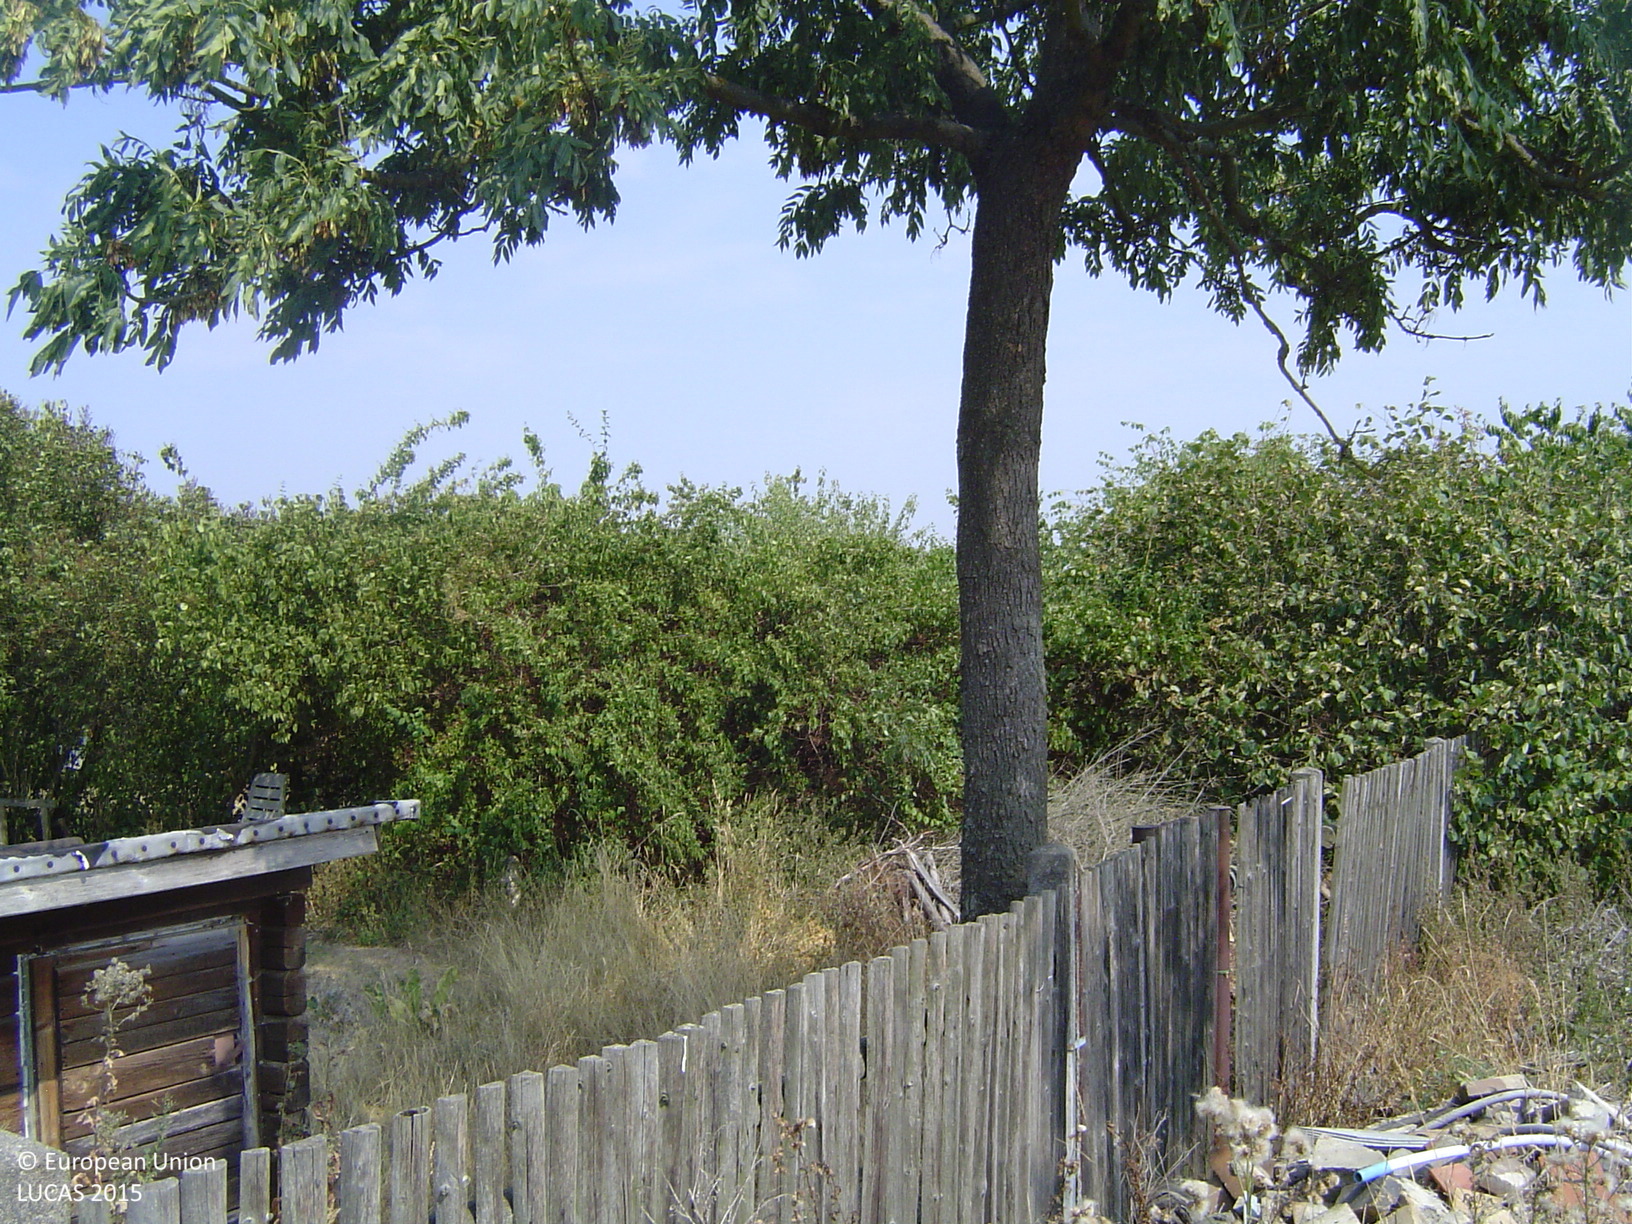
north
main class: Grassland
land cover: Grassland without tree/shrub cover
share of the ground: > 75 %
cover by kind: herbaceous plants 100 %
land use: Residential
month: August
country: CZ
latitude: 50.0747
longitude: 14.0951
